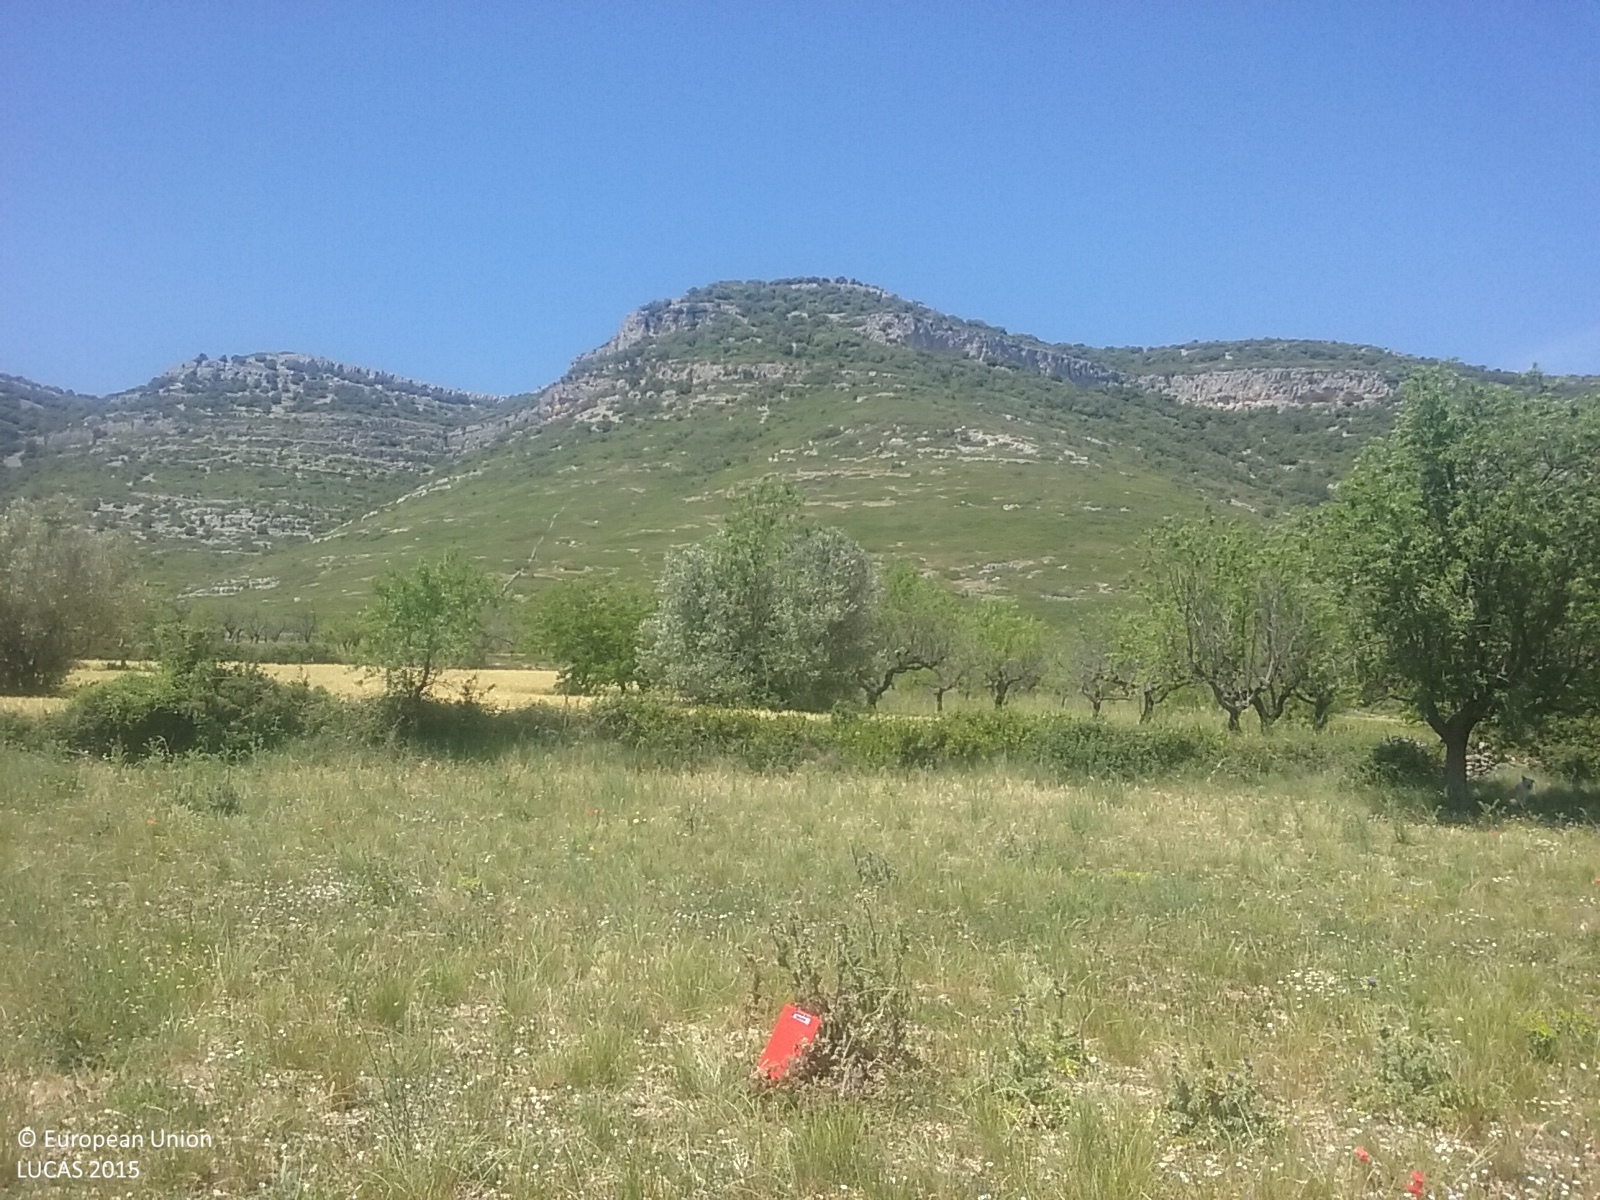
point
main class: Grassland
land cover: Spontaneously vegetated surfaces
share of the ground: > 75 %
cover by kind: herbaceous plants 95 %
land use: Fallow land
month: May
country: ES
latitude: 40.5043
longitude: 0.0229
